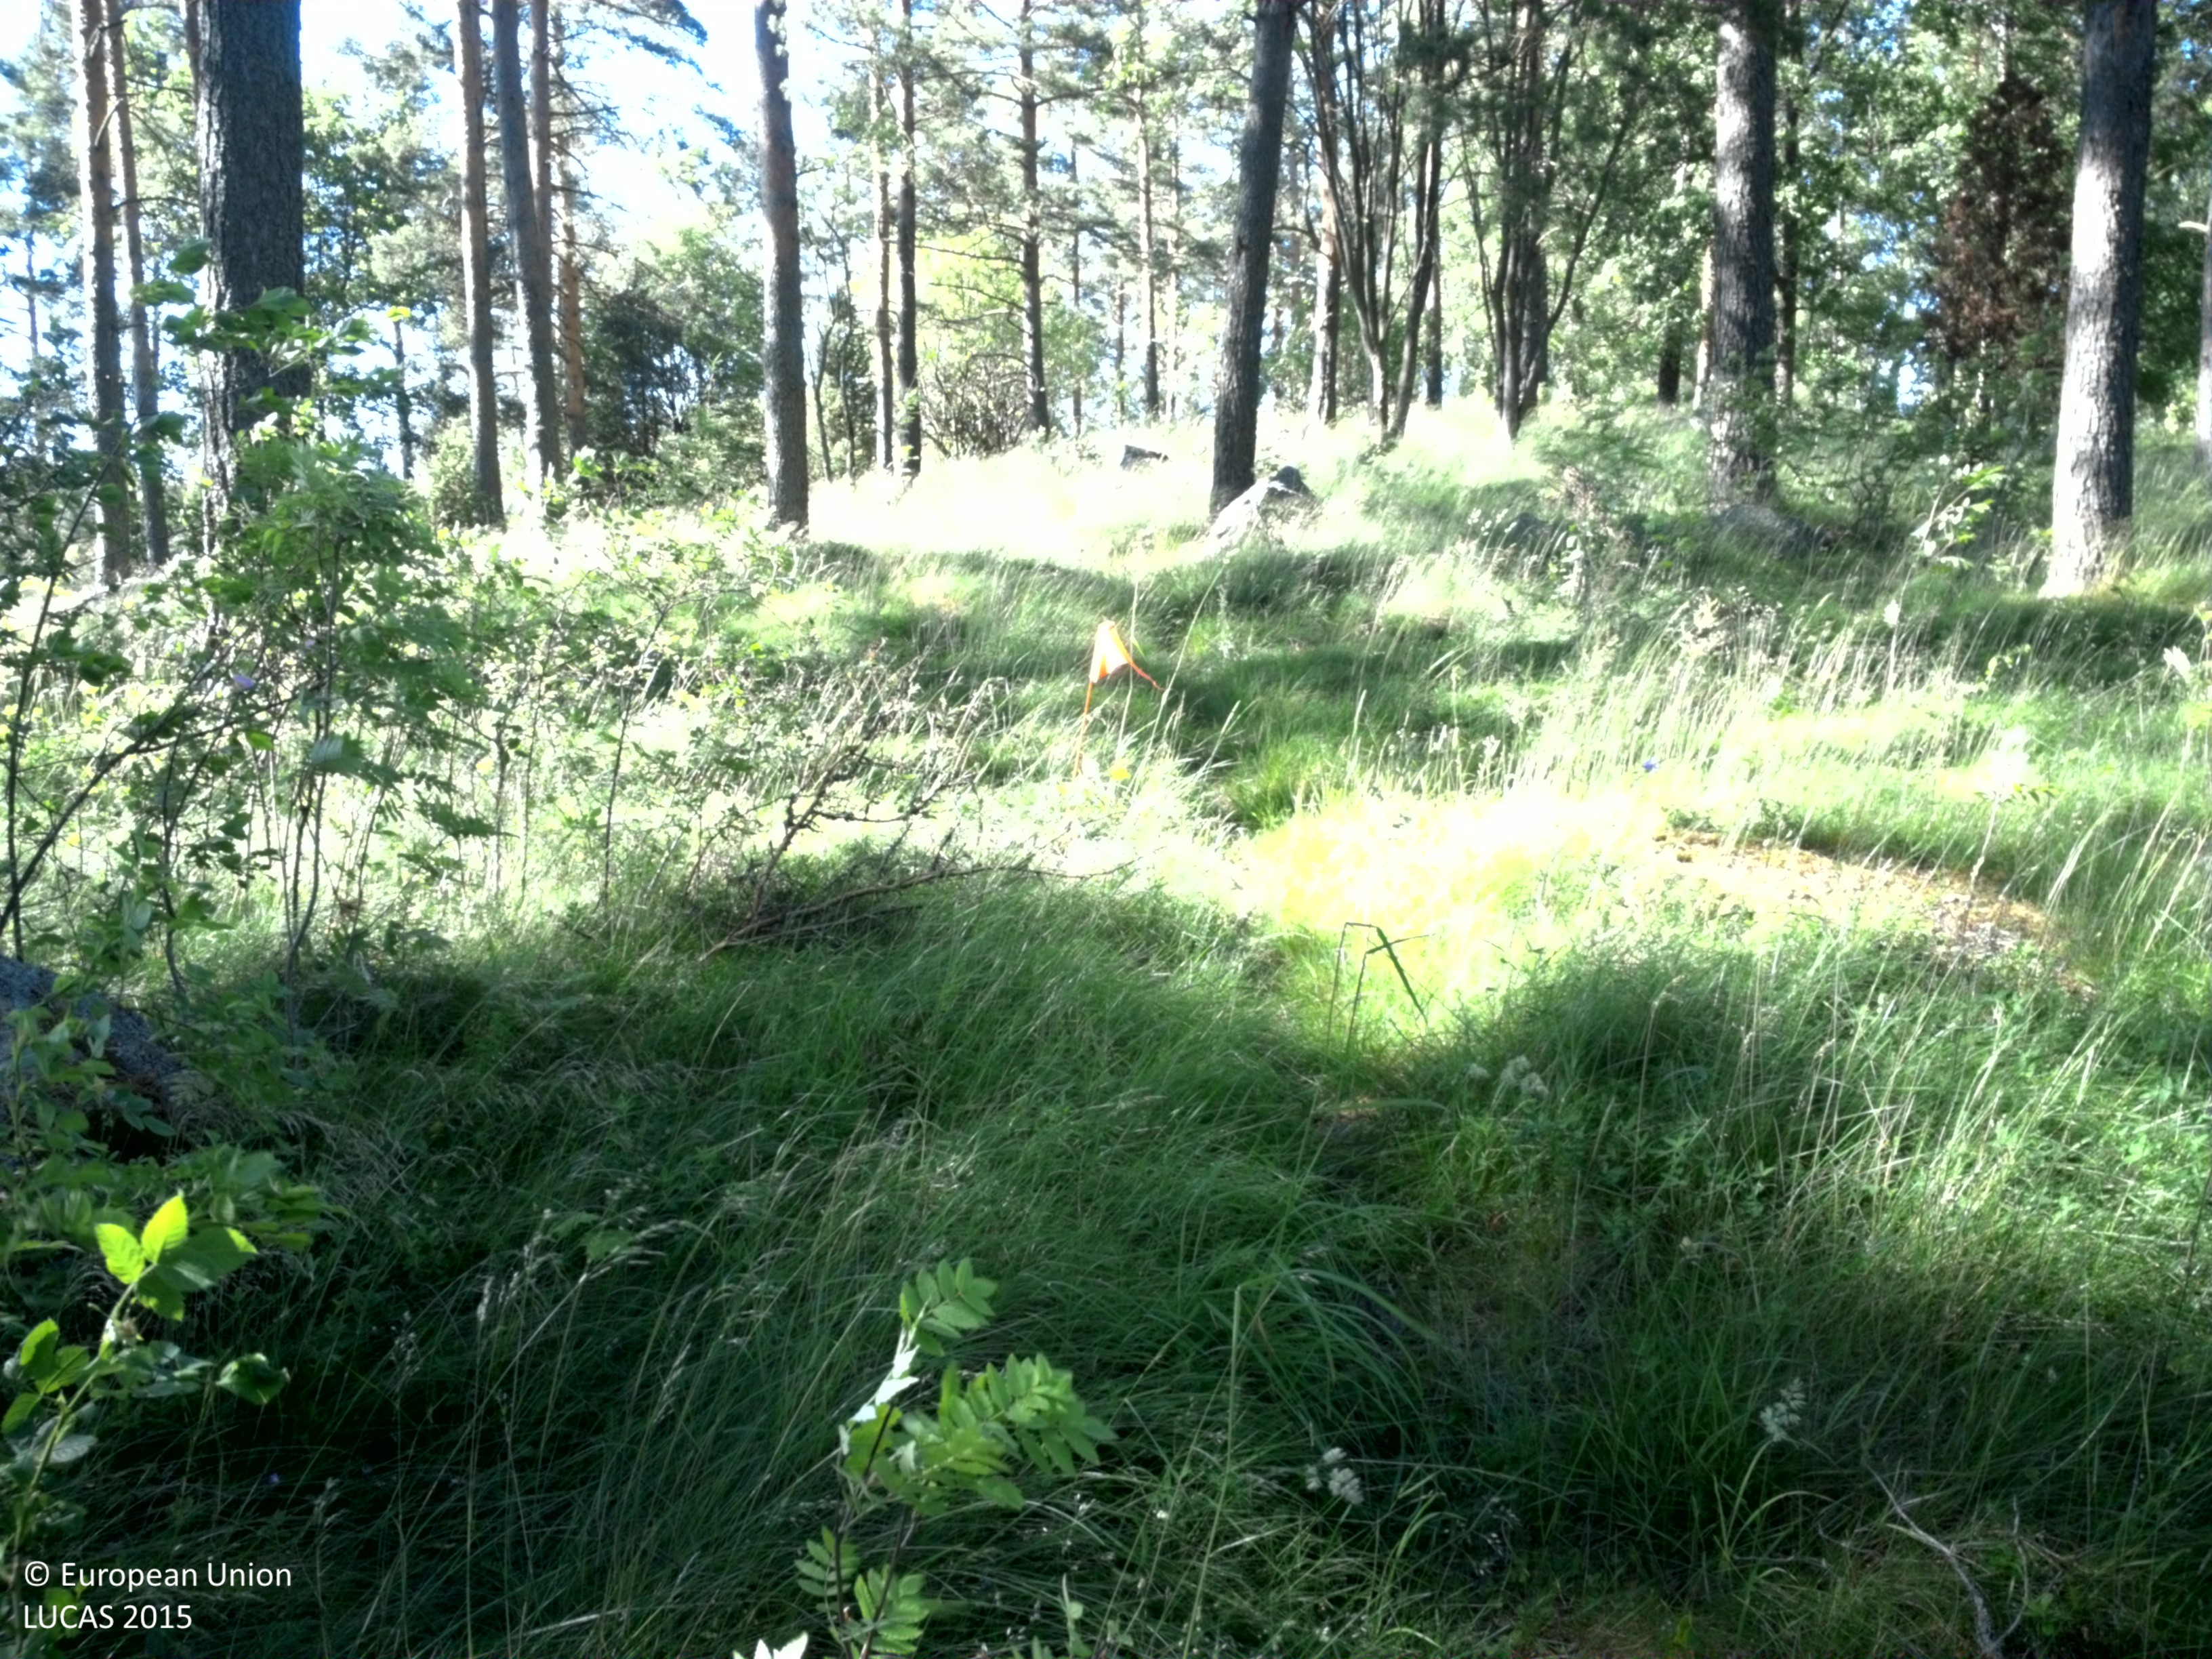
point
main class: Woodland
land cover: Pine dominated coniferous woodland
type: boreal forest
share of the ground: 50 - 75 %
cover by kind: coniferous forest trees 50 %, herbaceous plants 45 %, broadleaved forest trees 5 %
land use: Forestry
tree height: > 5 m
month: July
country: SE
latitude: 59.7436
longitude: 18.4859
